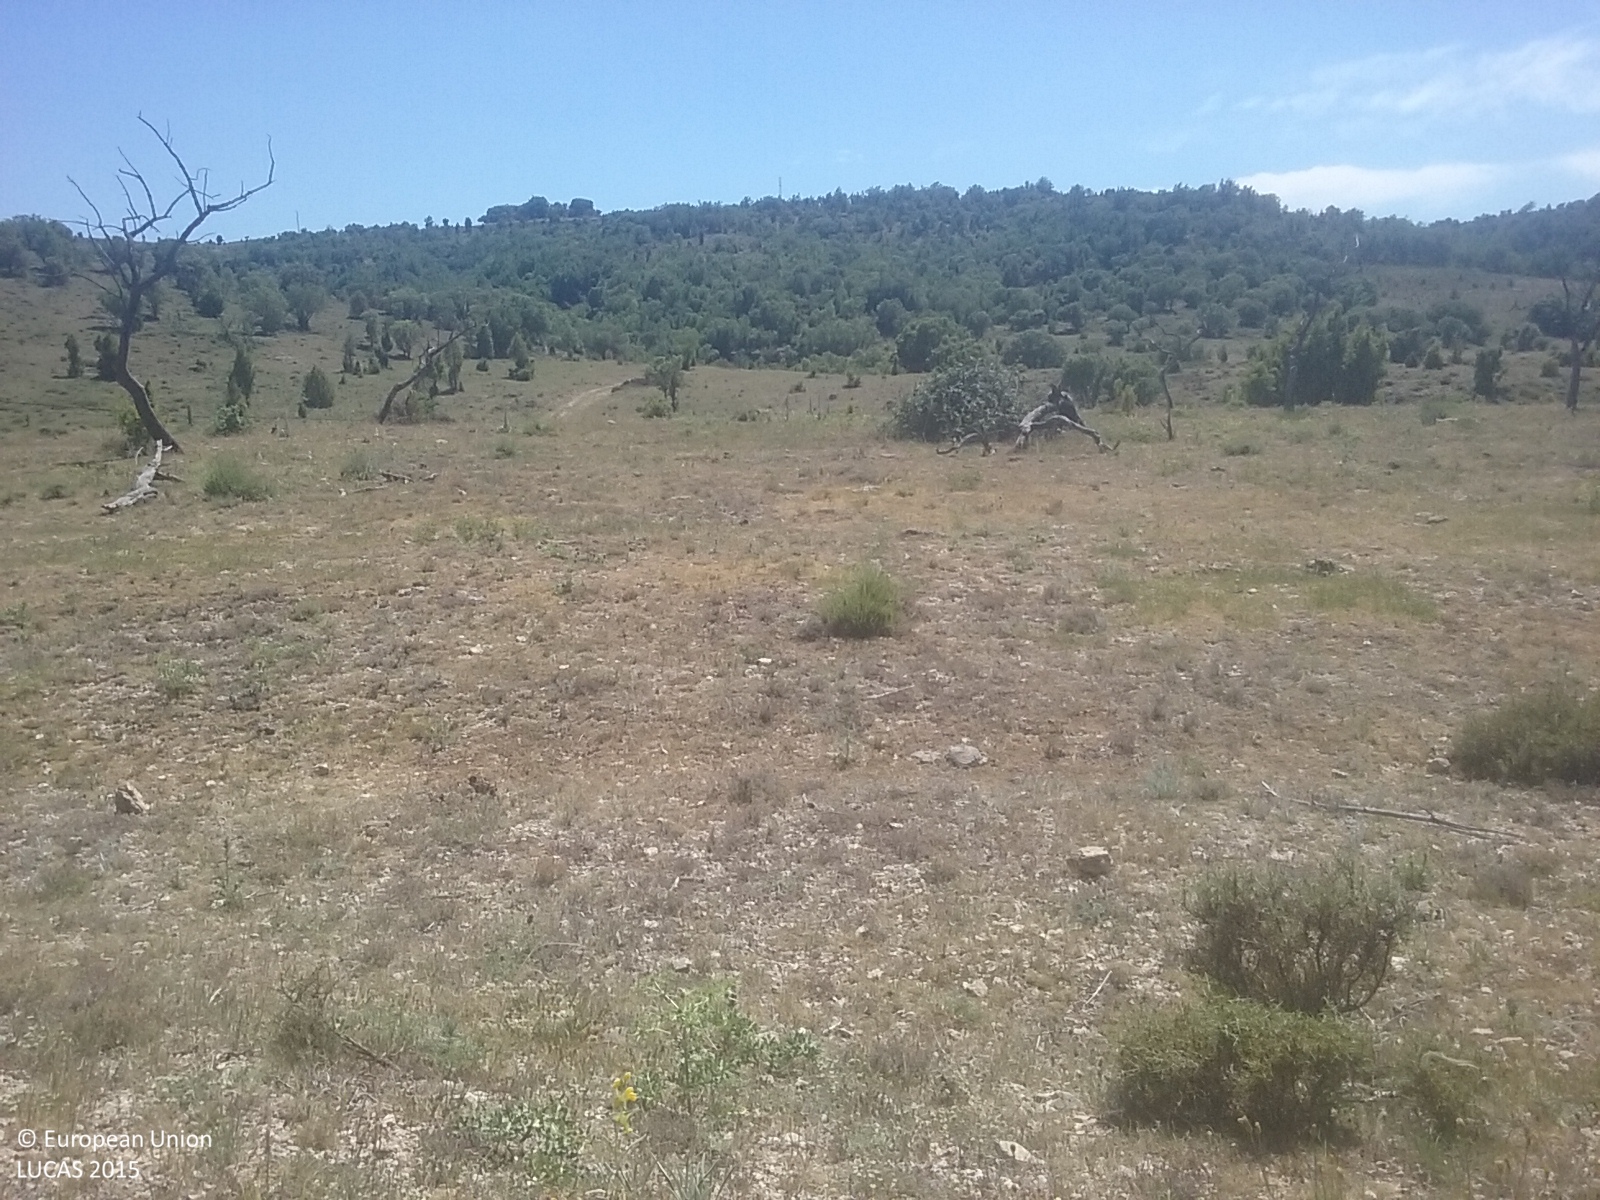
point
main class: Grassland
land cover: Grassland without tree/shrub cover
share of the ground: > 75 %
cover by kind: herbaceous plants 95 %, shrubs 5 %
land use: Agriculture (excluding fallow land and kitchen gardens)
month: June
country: ES
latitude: 40.6047
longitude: -0.0642
